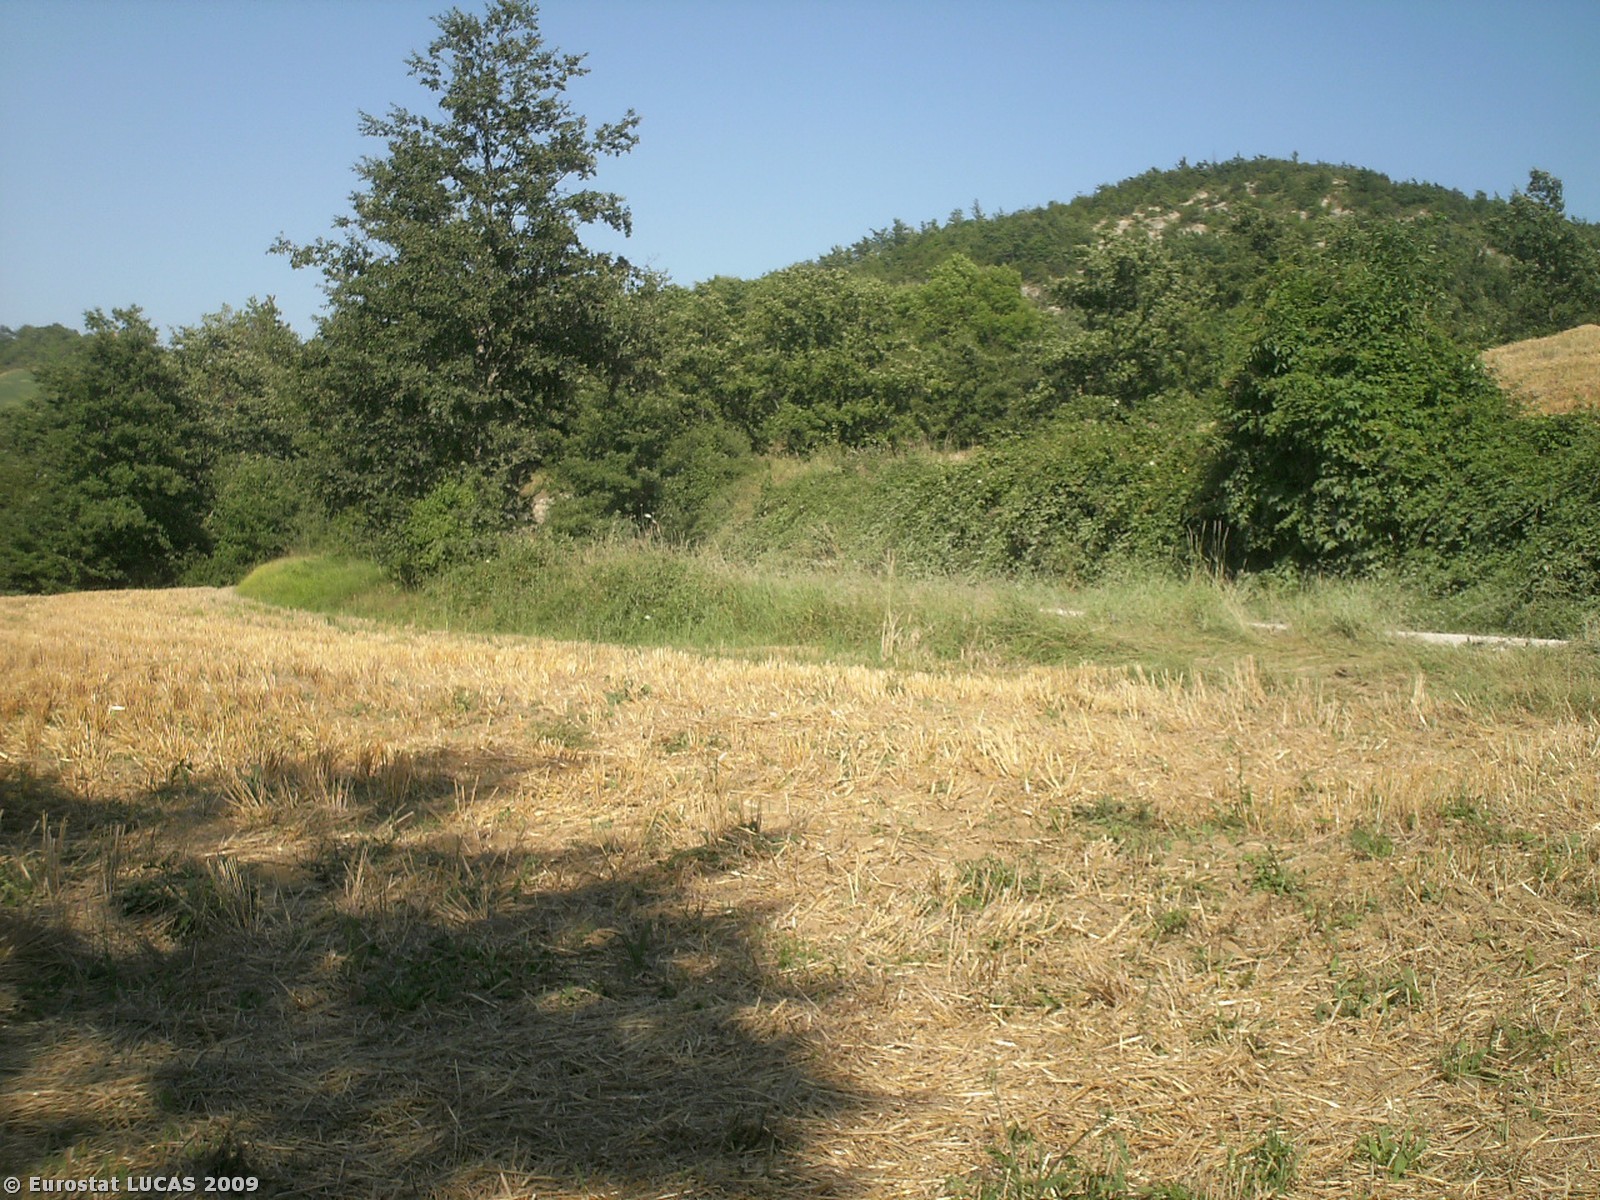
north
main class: Woodland
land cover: Mixed woodland
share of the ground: > 75 %
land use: Unused
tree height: > 5 m
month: July
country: IT
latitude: 43.6007
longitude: 12.4095
